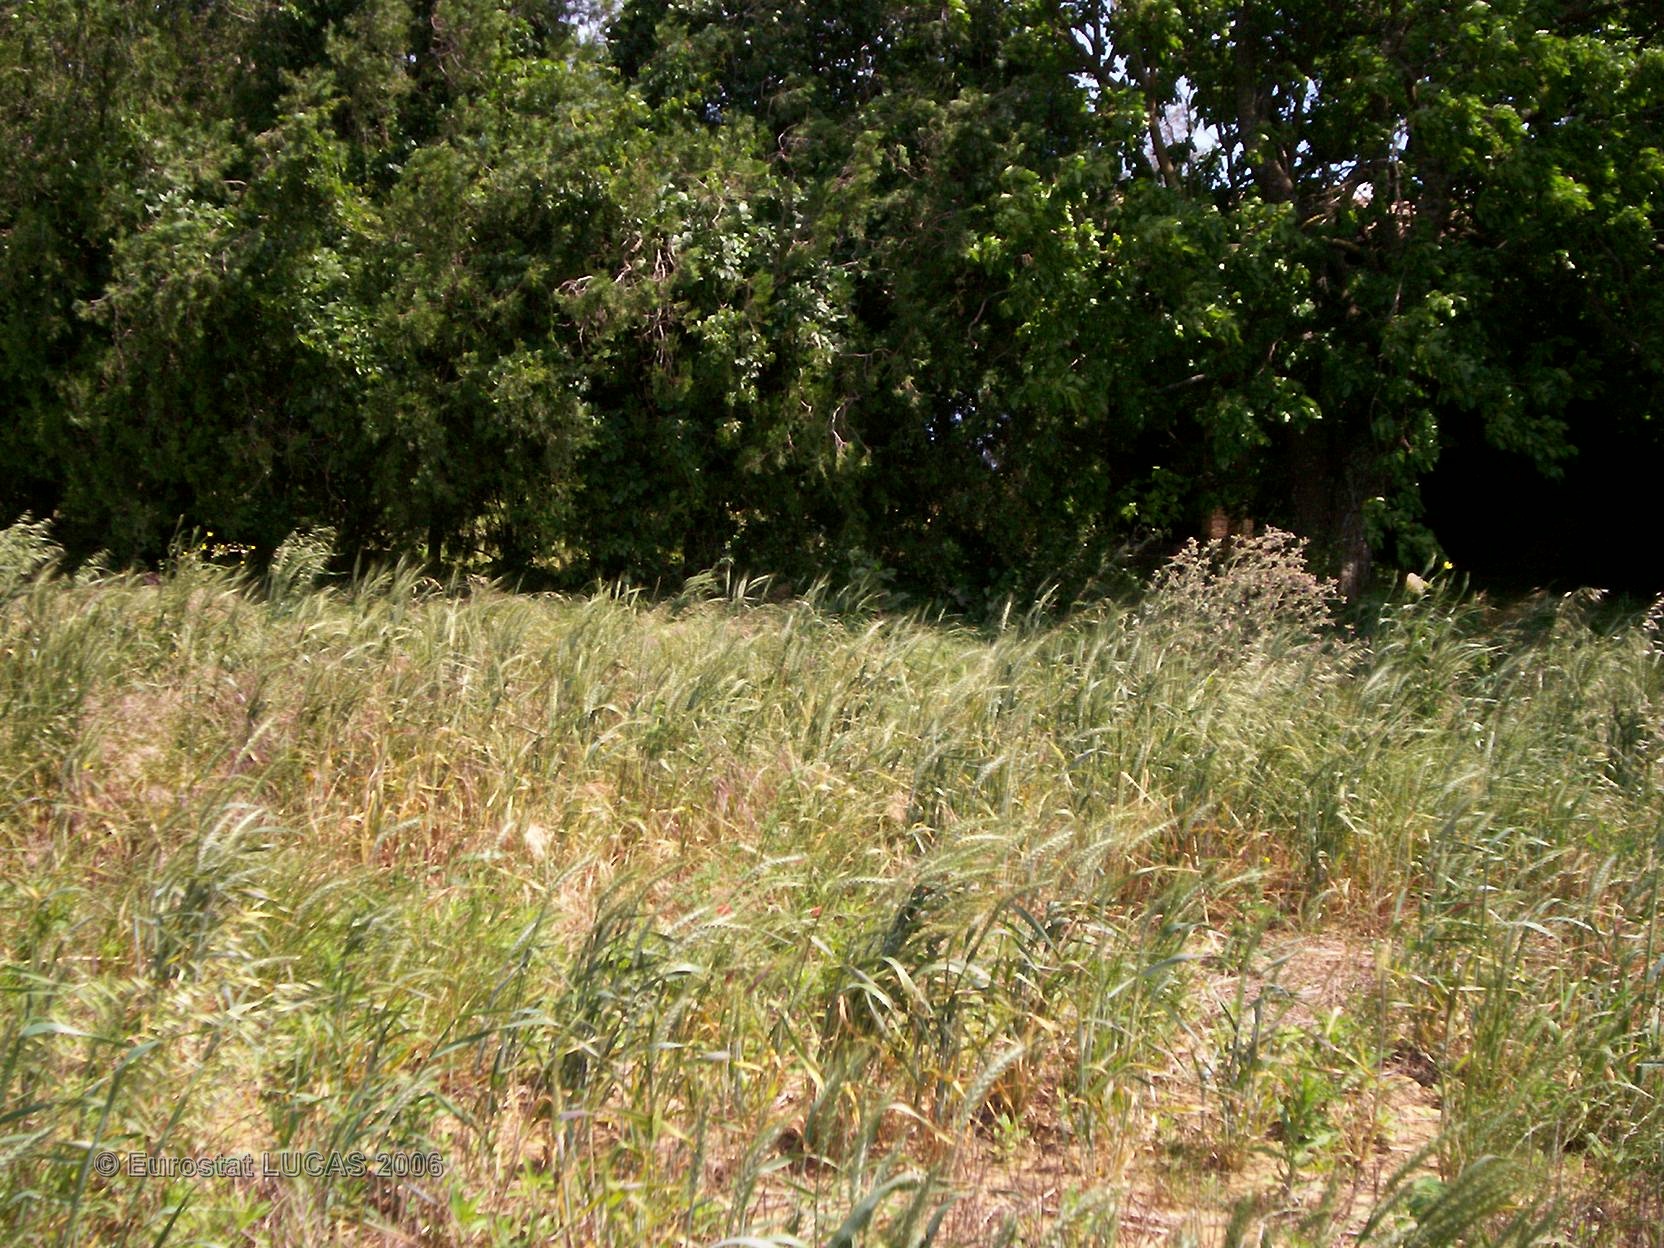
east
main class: Grassland
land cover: Grassland without tree/shrub cover
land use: Fallow land
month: June
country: FR
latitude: 44.8937
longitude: 4.9029
